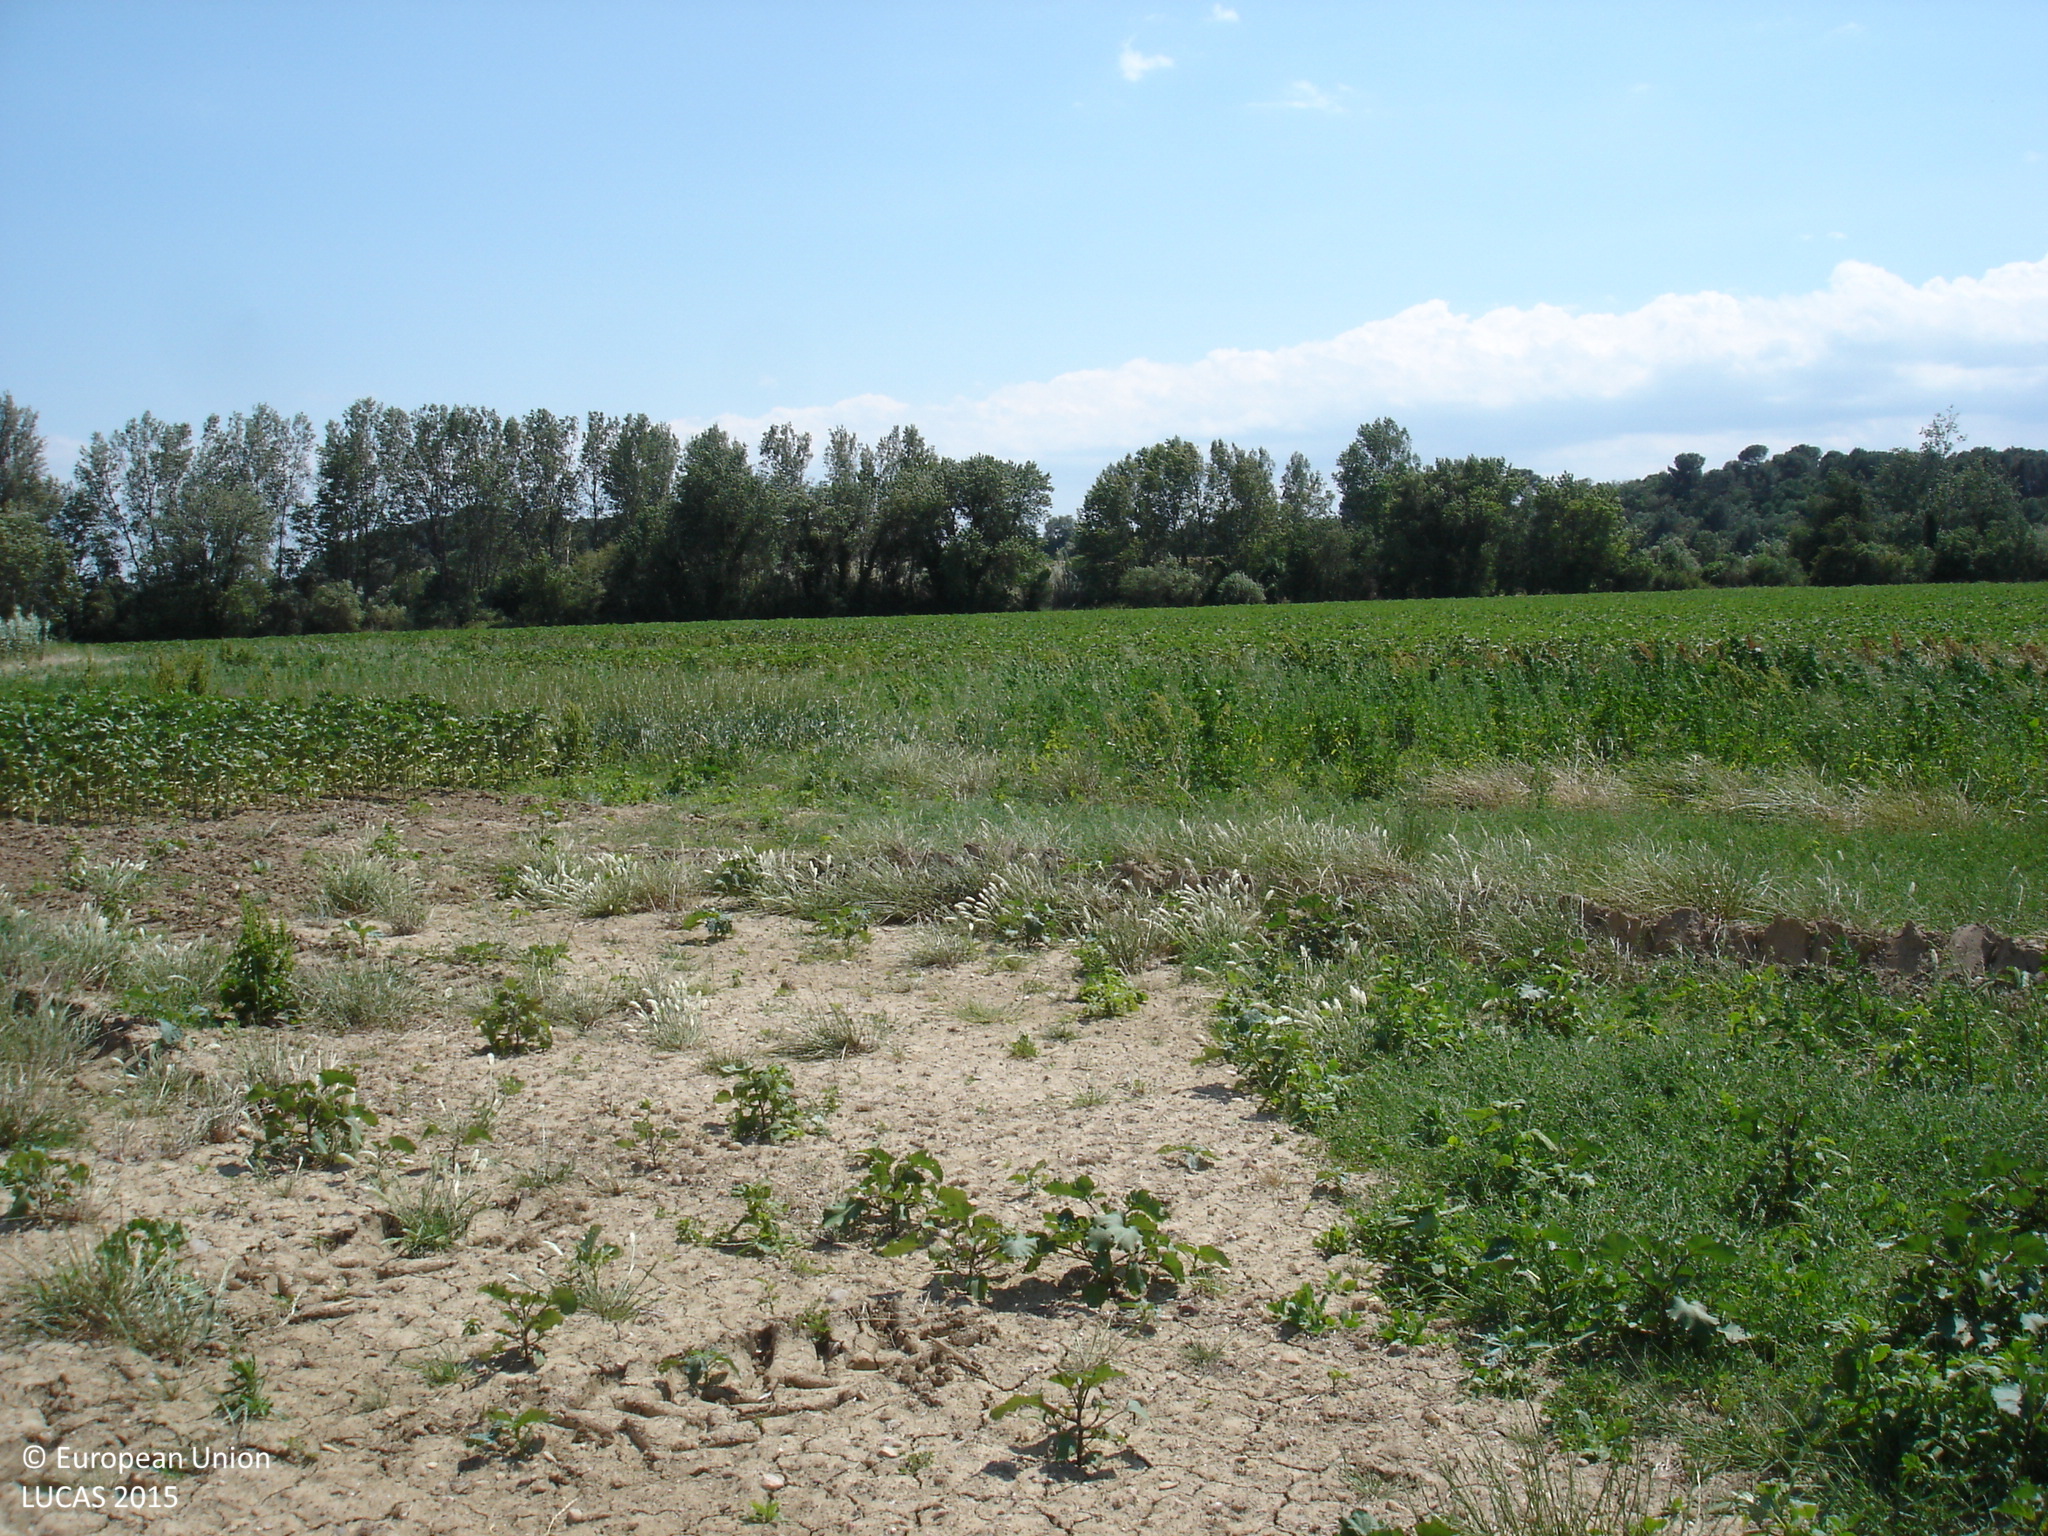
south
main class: Grassland
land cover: Grassland without tree/shrub cover
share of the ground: 10 - 25 %
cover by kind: consolidated bare surface 90 %, herbaceous plants 10 %
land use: Agriculture (excluding fallow land and kitchen gardens)
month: May
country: ES
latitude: 42.2124
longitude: 3.0010
